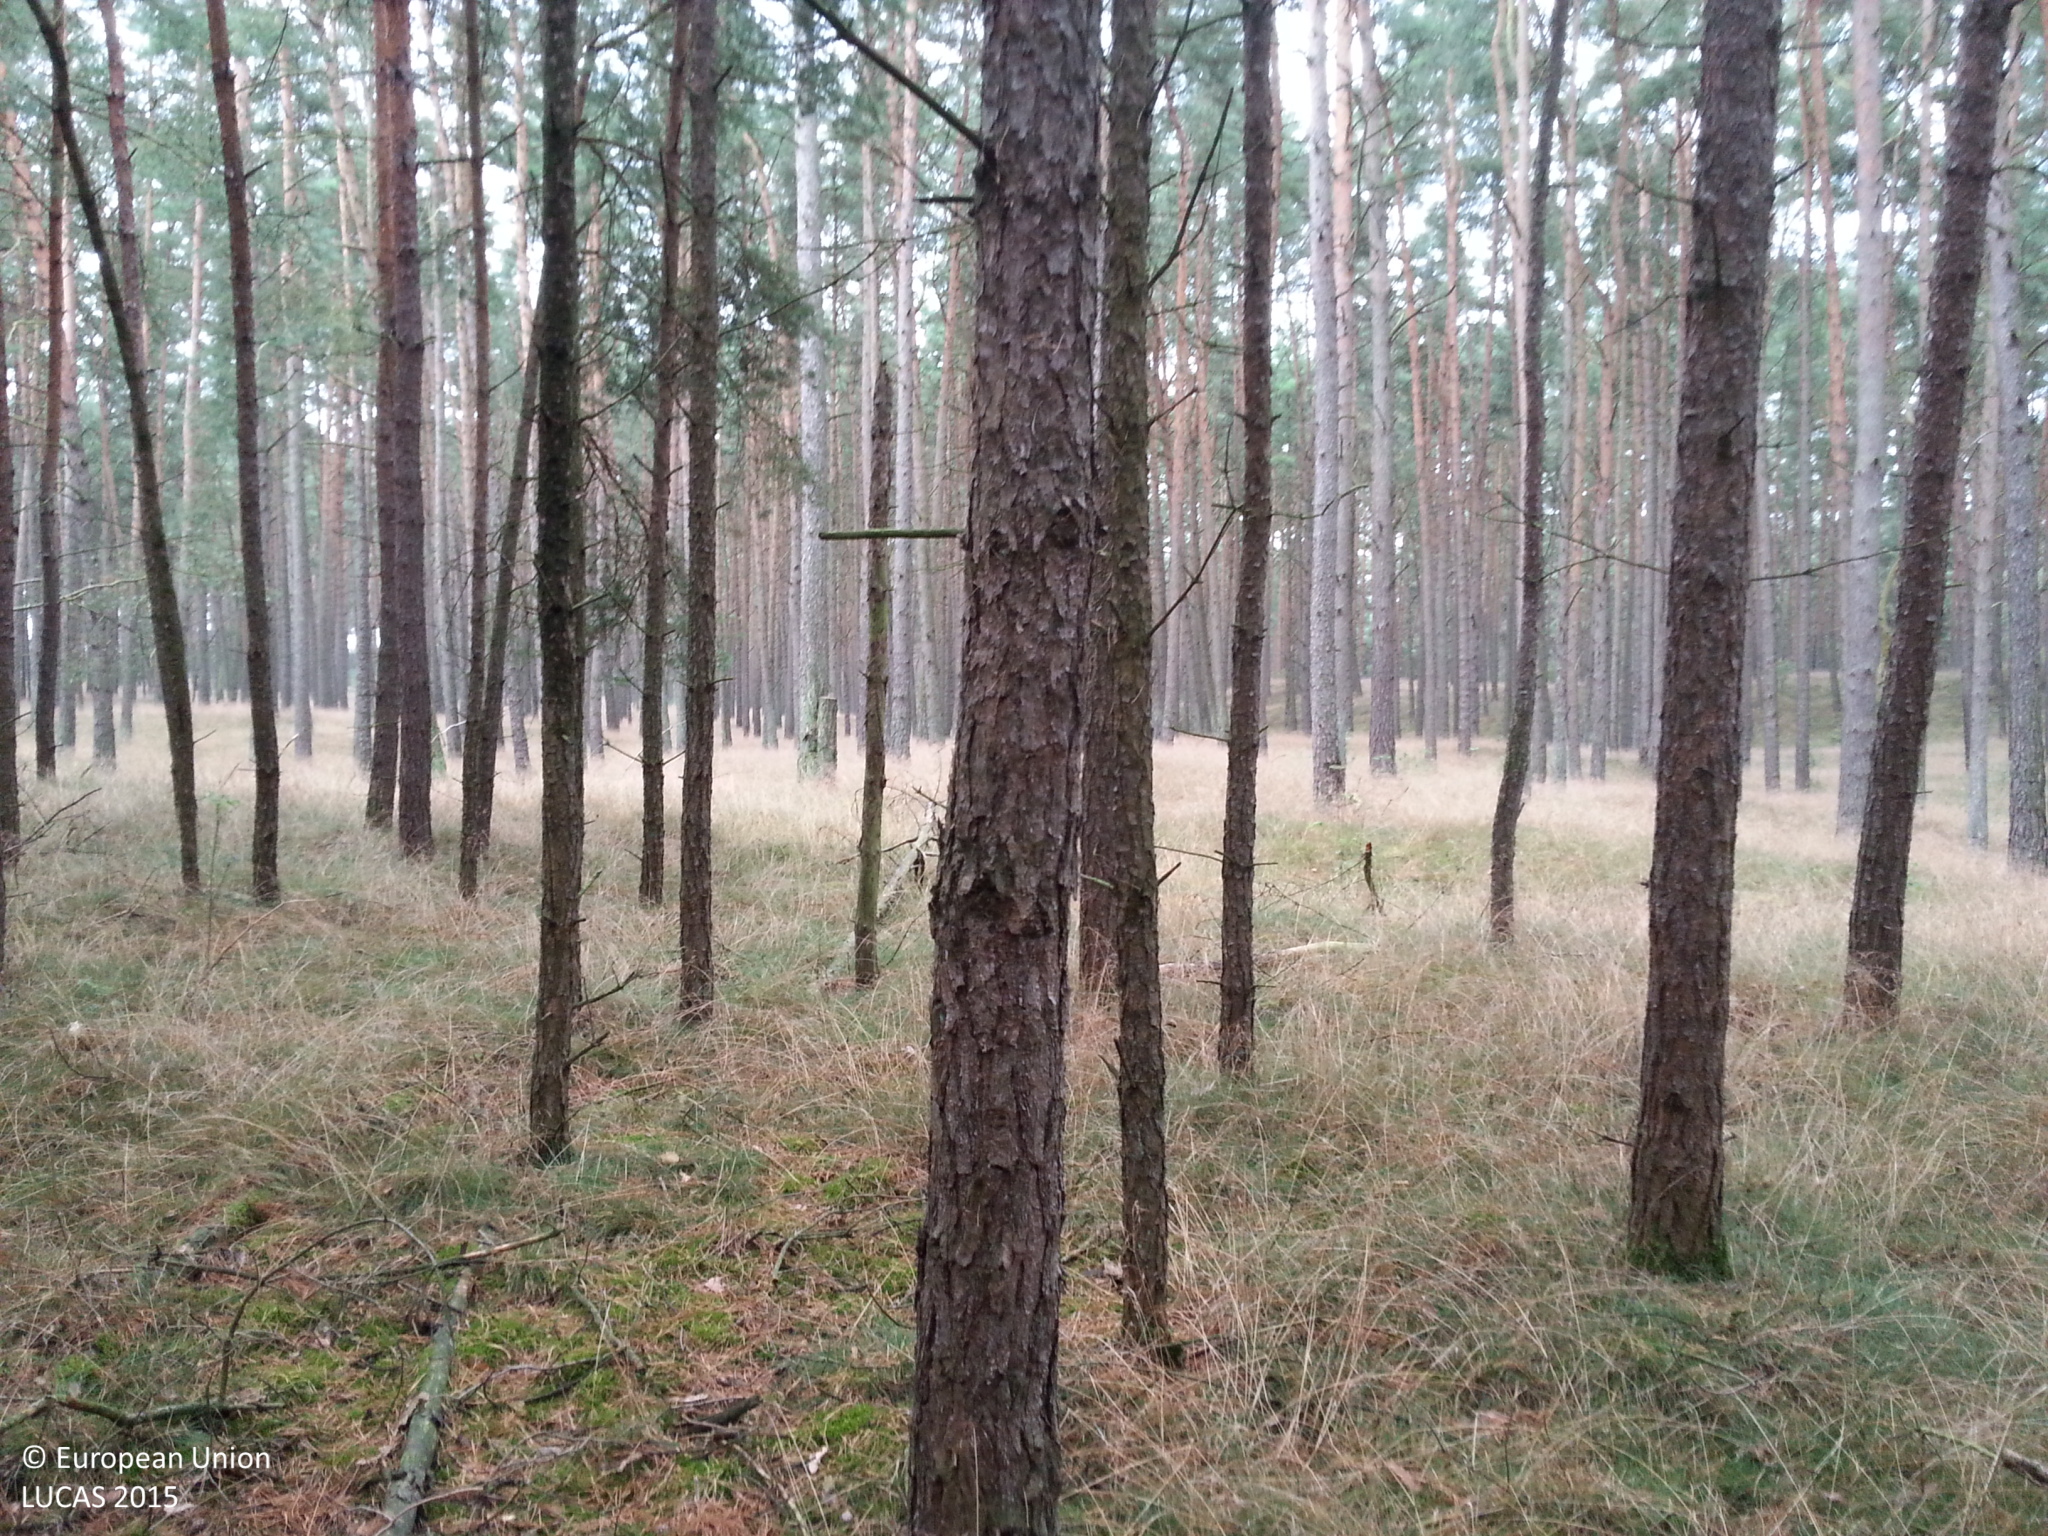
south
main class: Woodland
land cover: Pine dominated coniferous woodland
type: hemiboreal forest and nemoral coniferous forest and mixed broadleaved-coniferous forest
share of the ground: > 75 %
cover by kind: coniferous forest trees 80 %, herbaceous plants 20 %
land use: Forestry
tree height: > 5 m
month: August
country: DE
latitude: 53.2490
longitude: 11.4831
